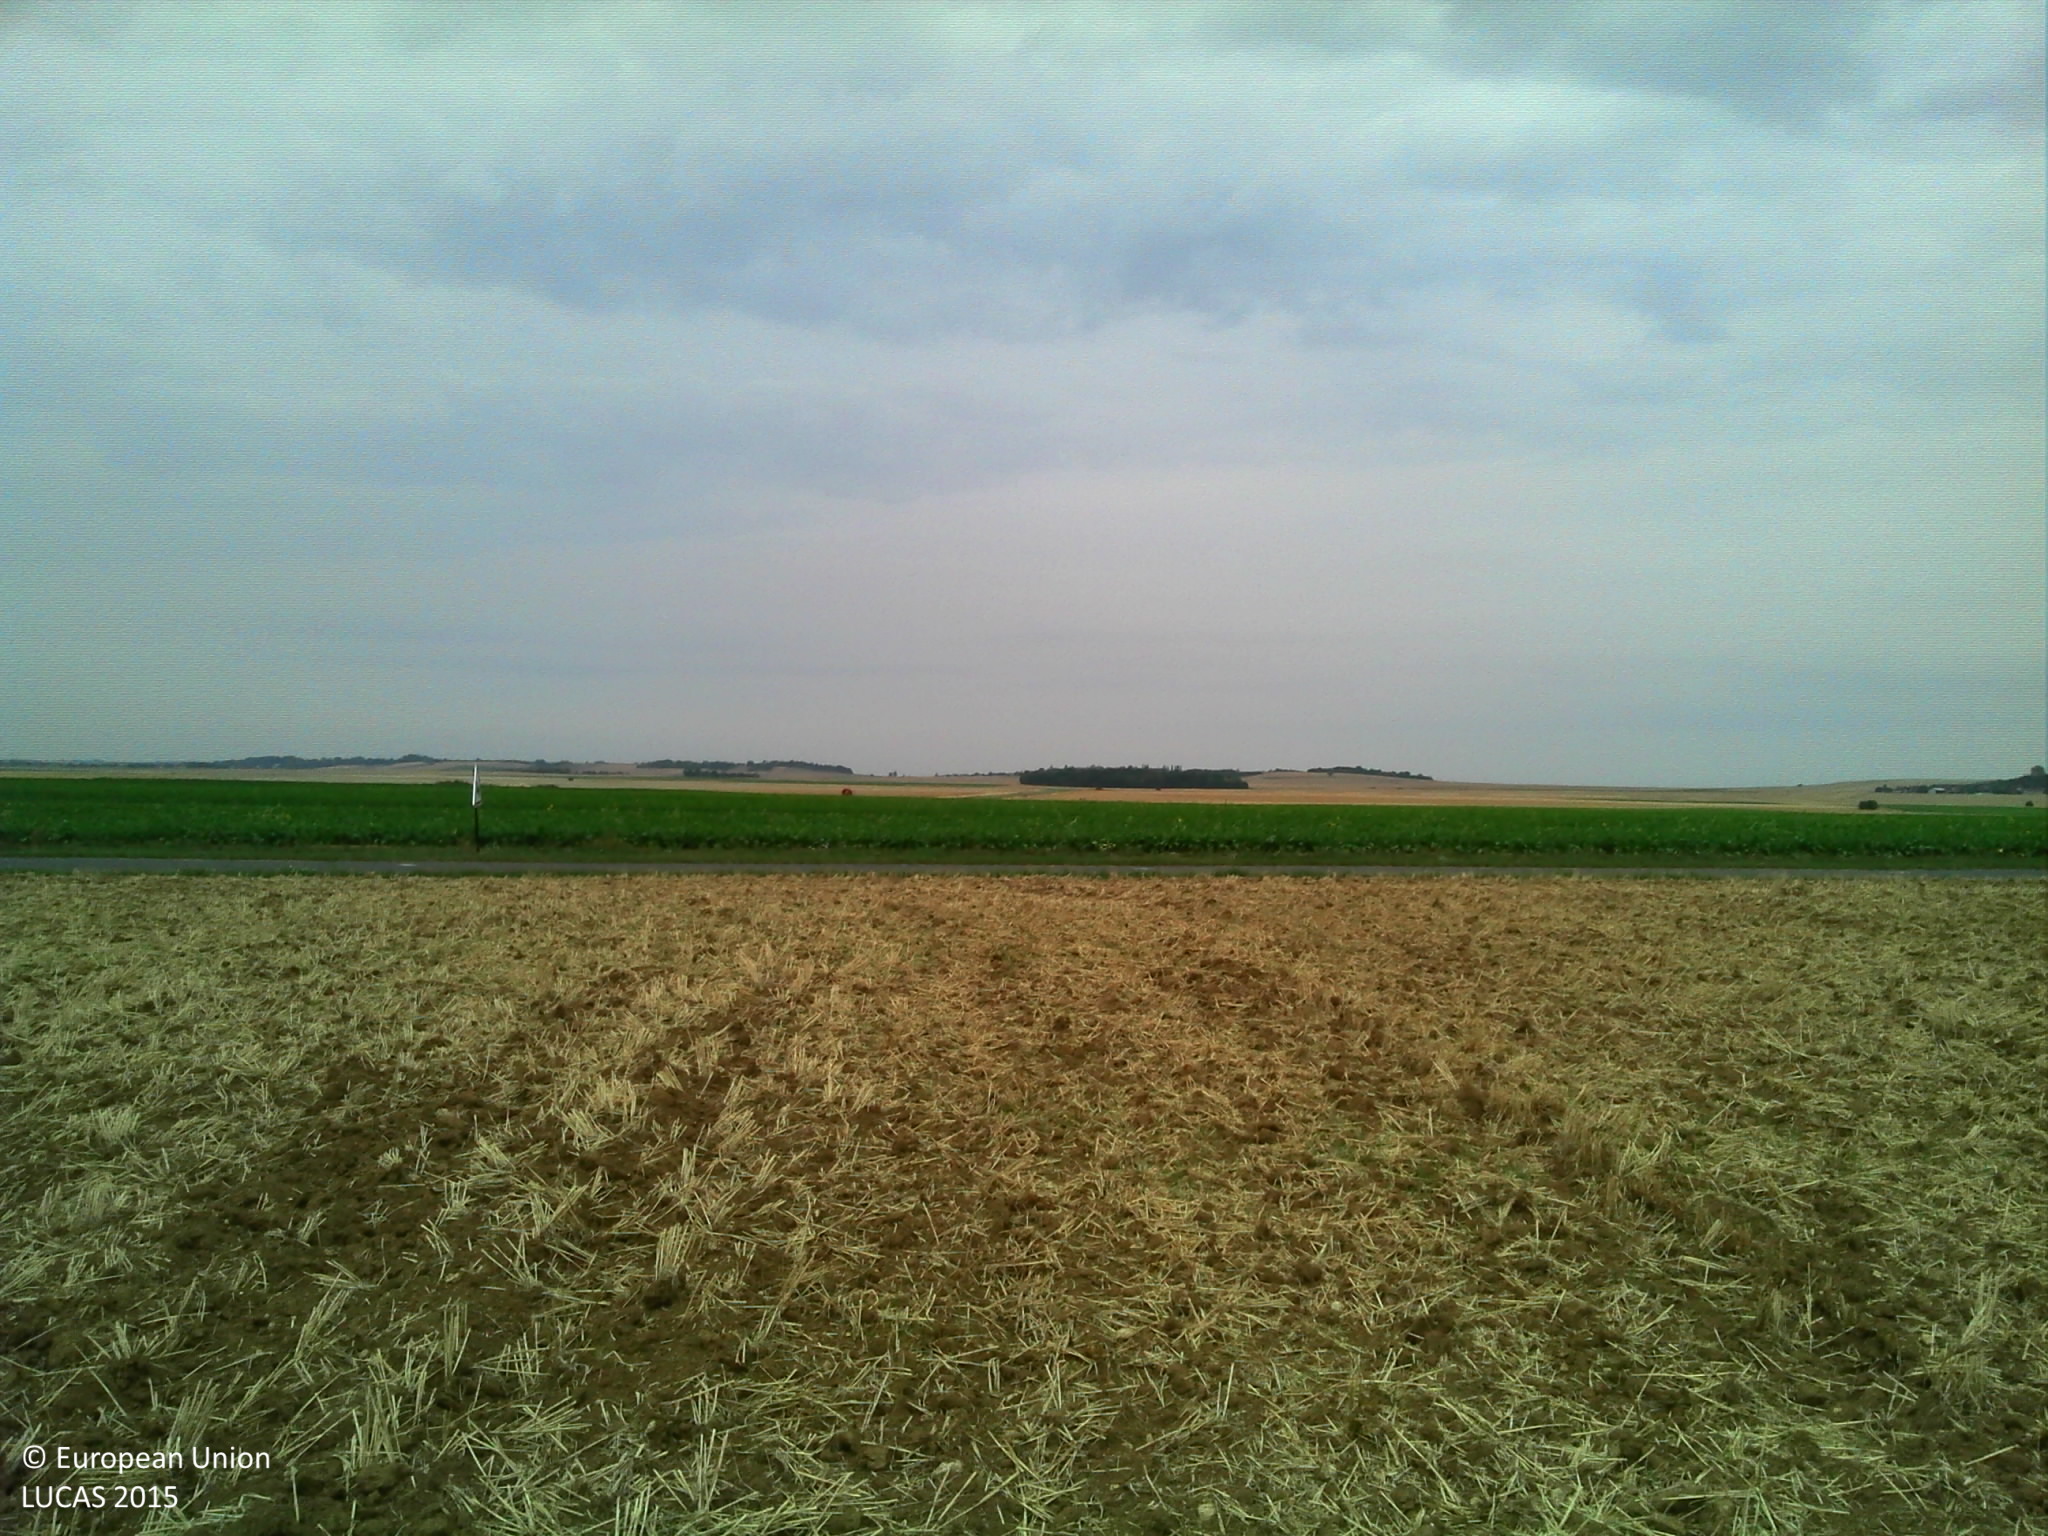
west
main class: Cropland
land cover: Common wheat
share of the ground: 25 - 50 %
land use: Agriculture (excluding fallow land and kitchen gardens)
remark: Harvested field
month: August
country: FR
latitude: 48.2061
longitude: 2.5490
